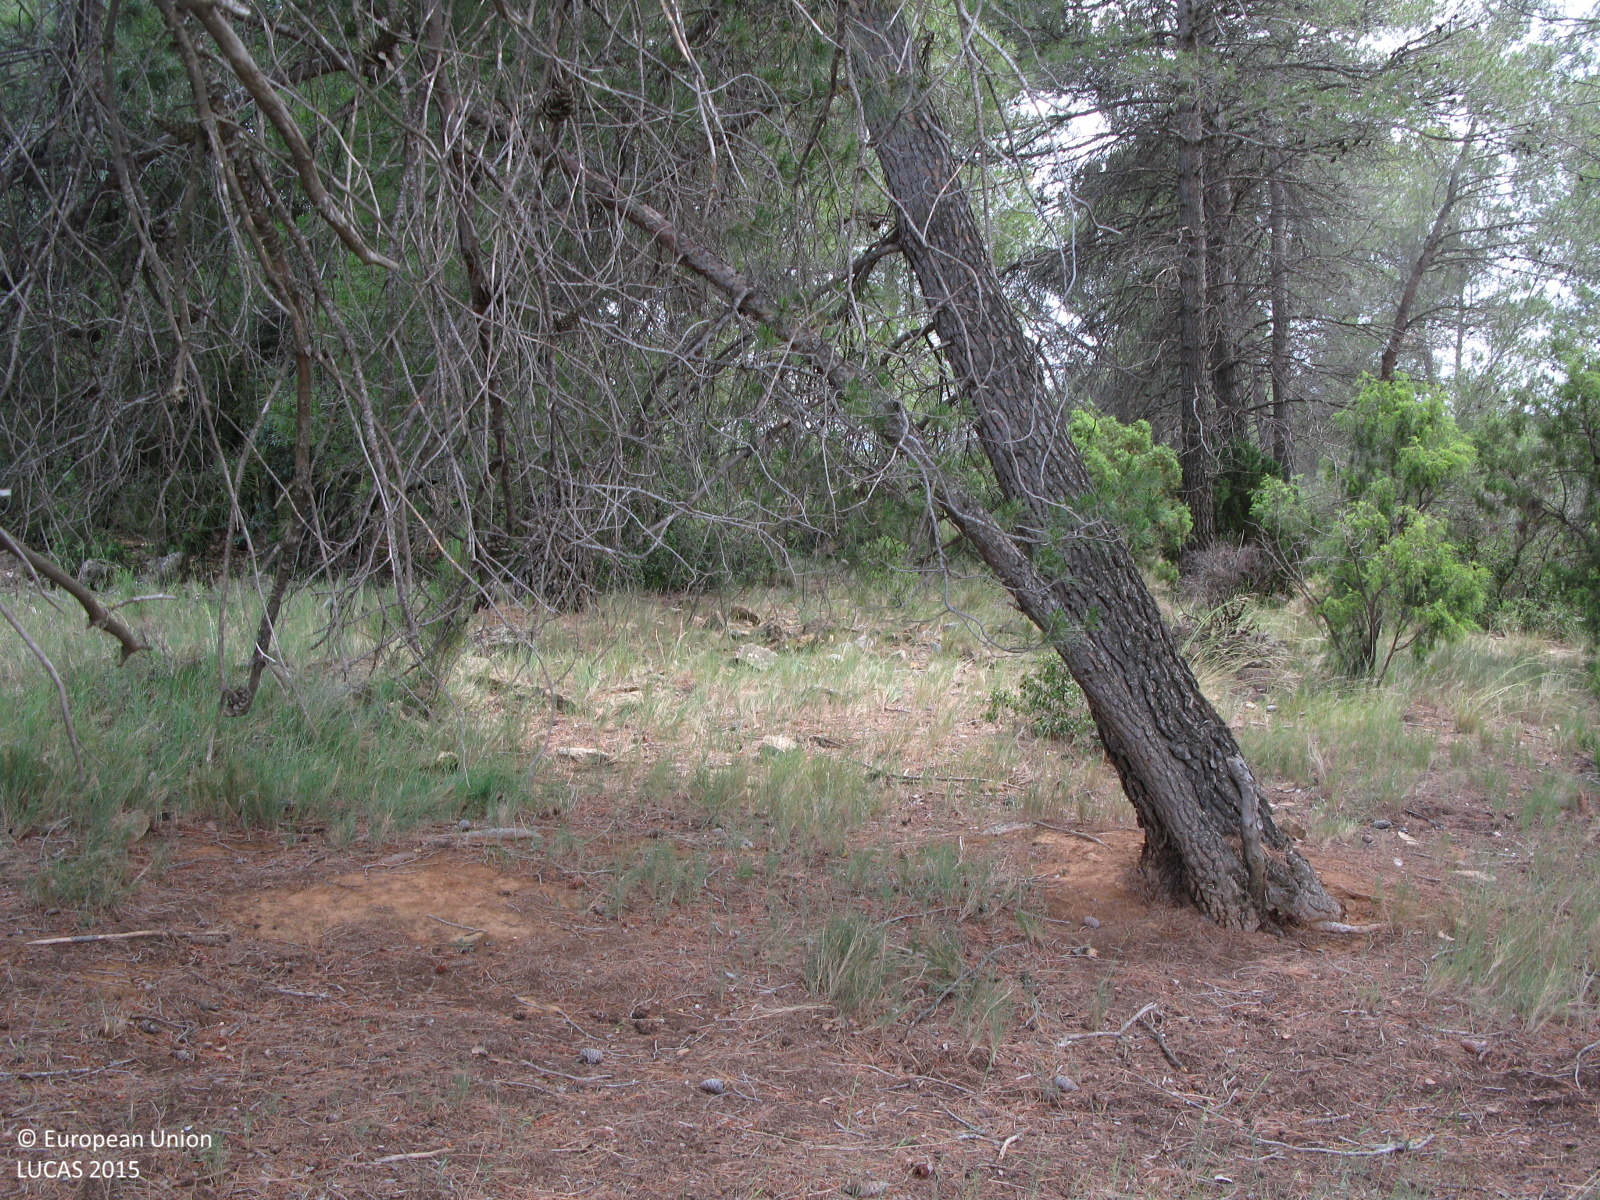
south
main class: Woodland
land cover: Pine dominated coniferous woodland
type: coniferous forest of the mediterranean region
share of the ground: 25 - 50 %
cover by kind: shrubs 40 %, herbaceous plants 30 %, coniferous forest trees 25 %, broadleaved forest trees 5 %
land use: Forestry
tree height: > 5 m
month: June
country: ES
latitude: 39.8320
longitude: -0.9762
